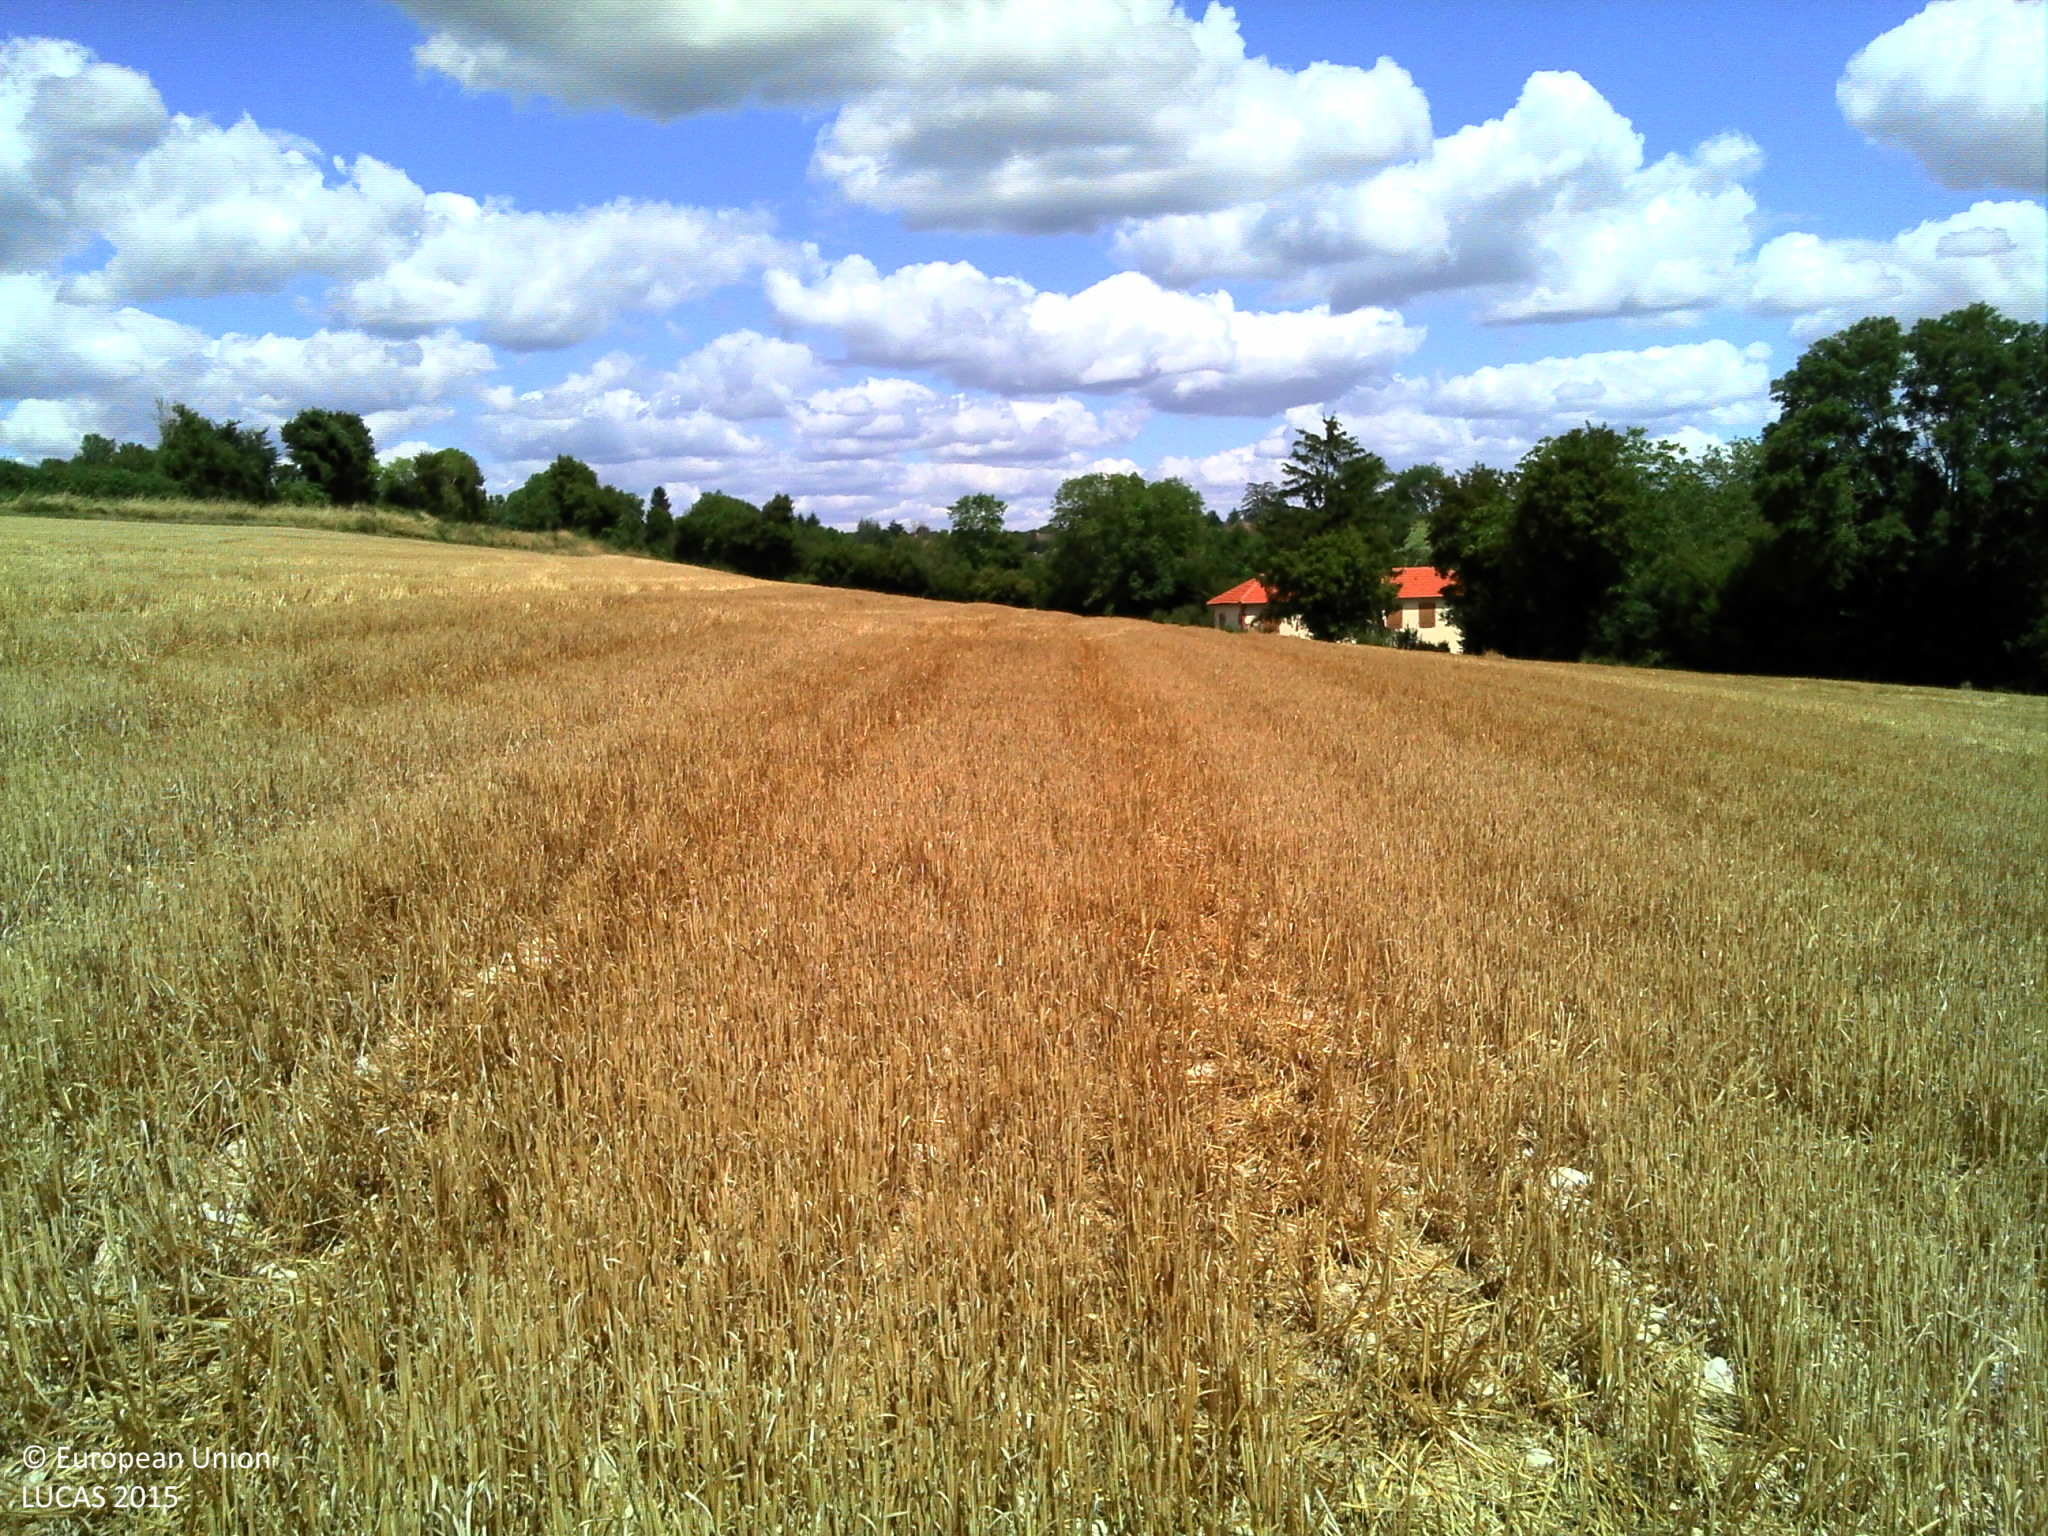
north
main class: Cropland
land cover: Common wheat
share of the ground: > 75 %
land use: Agriculture (excluding fallow land and kitchen gardens)
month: July
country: FR
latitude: 47.5427
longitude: 3.1792
